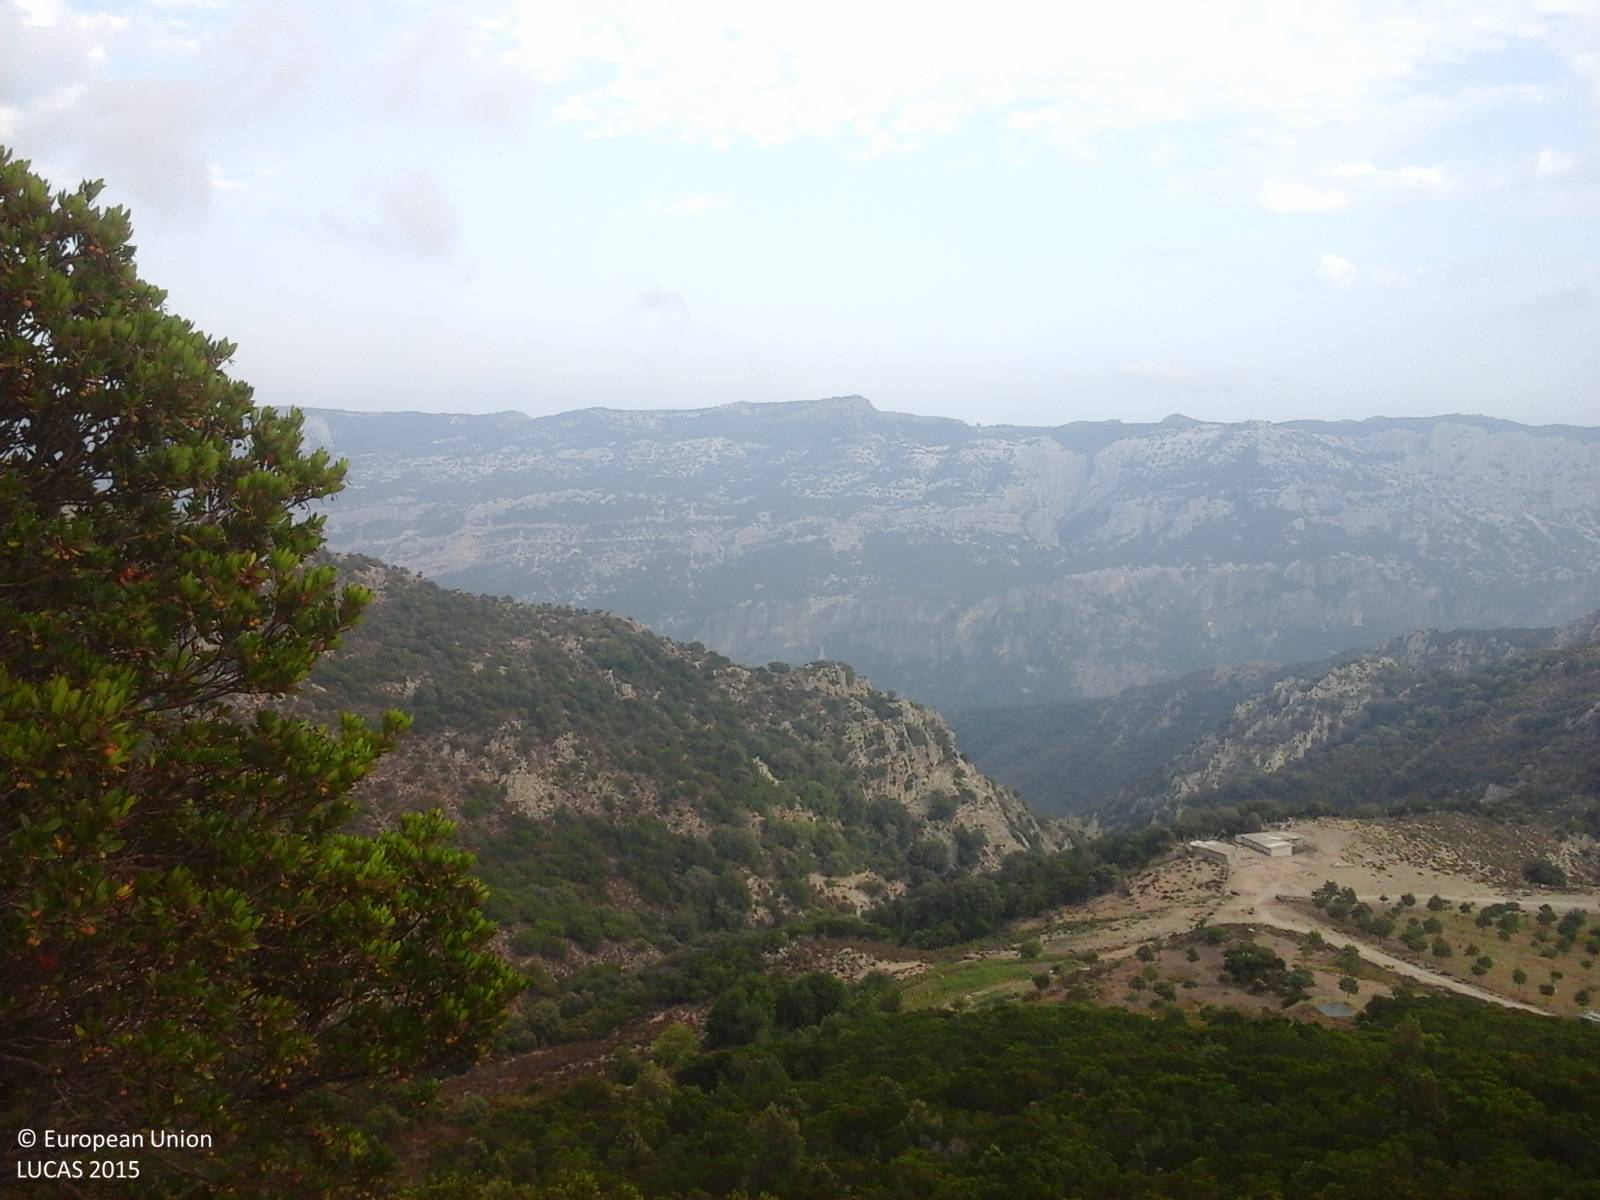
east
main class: Shrubland
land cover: Shrubland with sparse tree cover
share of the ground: > 75 %
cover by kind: shrubs 85 %, broadleaved forest trees 5 %, herbaceous plants 5 %, unconsolidated bare surface 5 %
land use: Agriculture (excluding fallow land and kitchen gardens)
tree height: < 5 m
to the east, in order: Shrubland with sparse tree cover; Shrubland without tree cover; Tracks; Shrubland without tree cover; Nuts trees; Grassland without tree/shrub cover; Tracks; Shrubland without tree cover
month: September
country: IT
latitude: 40.1575
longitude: 9.5212
